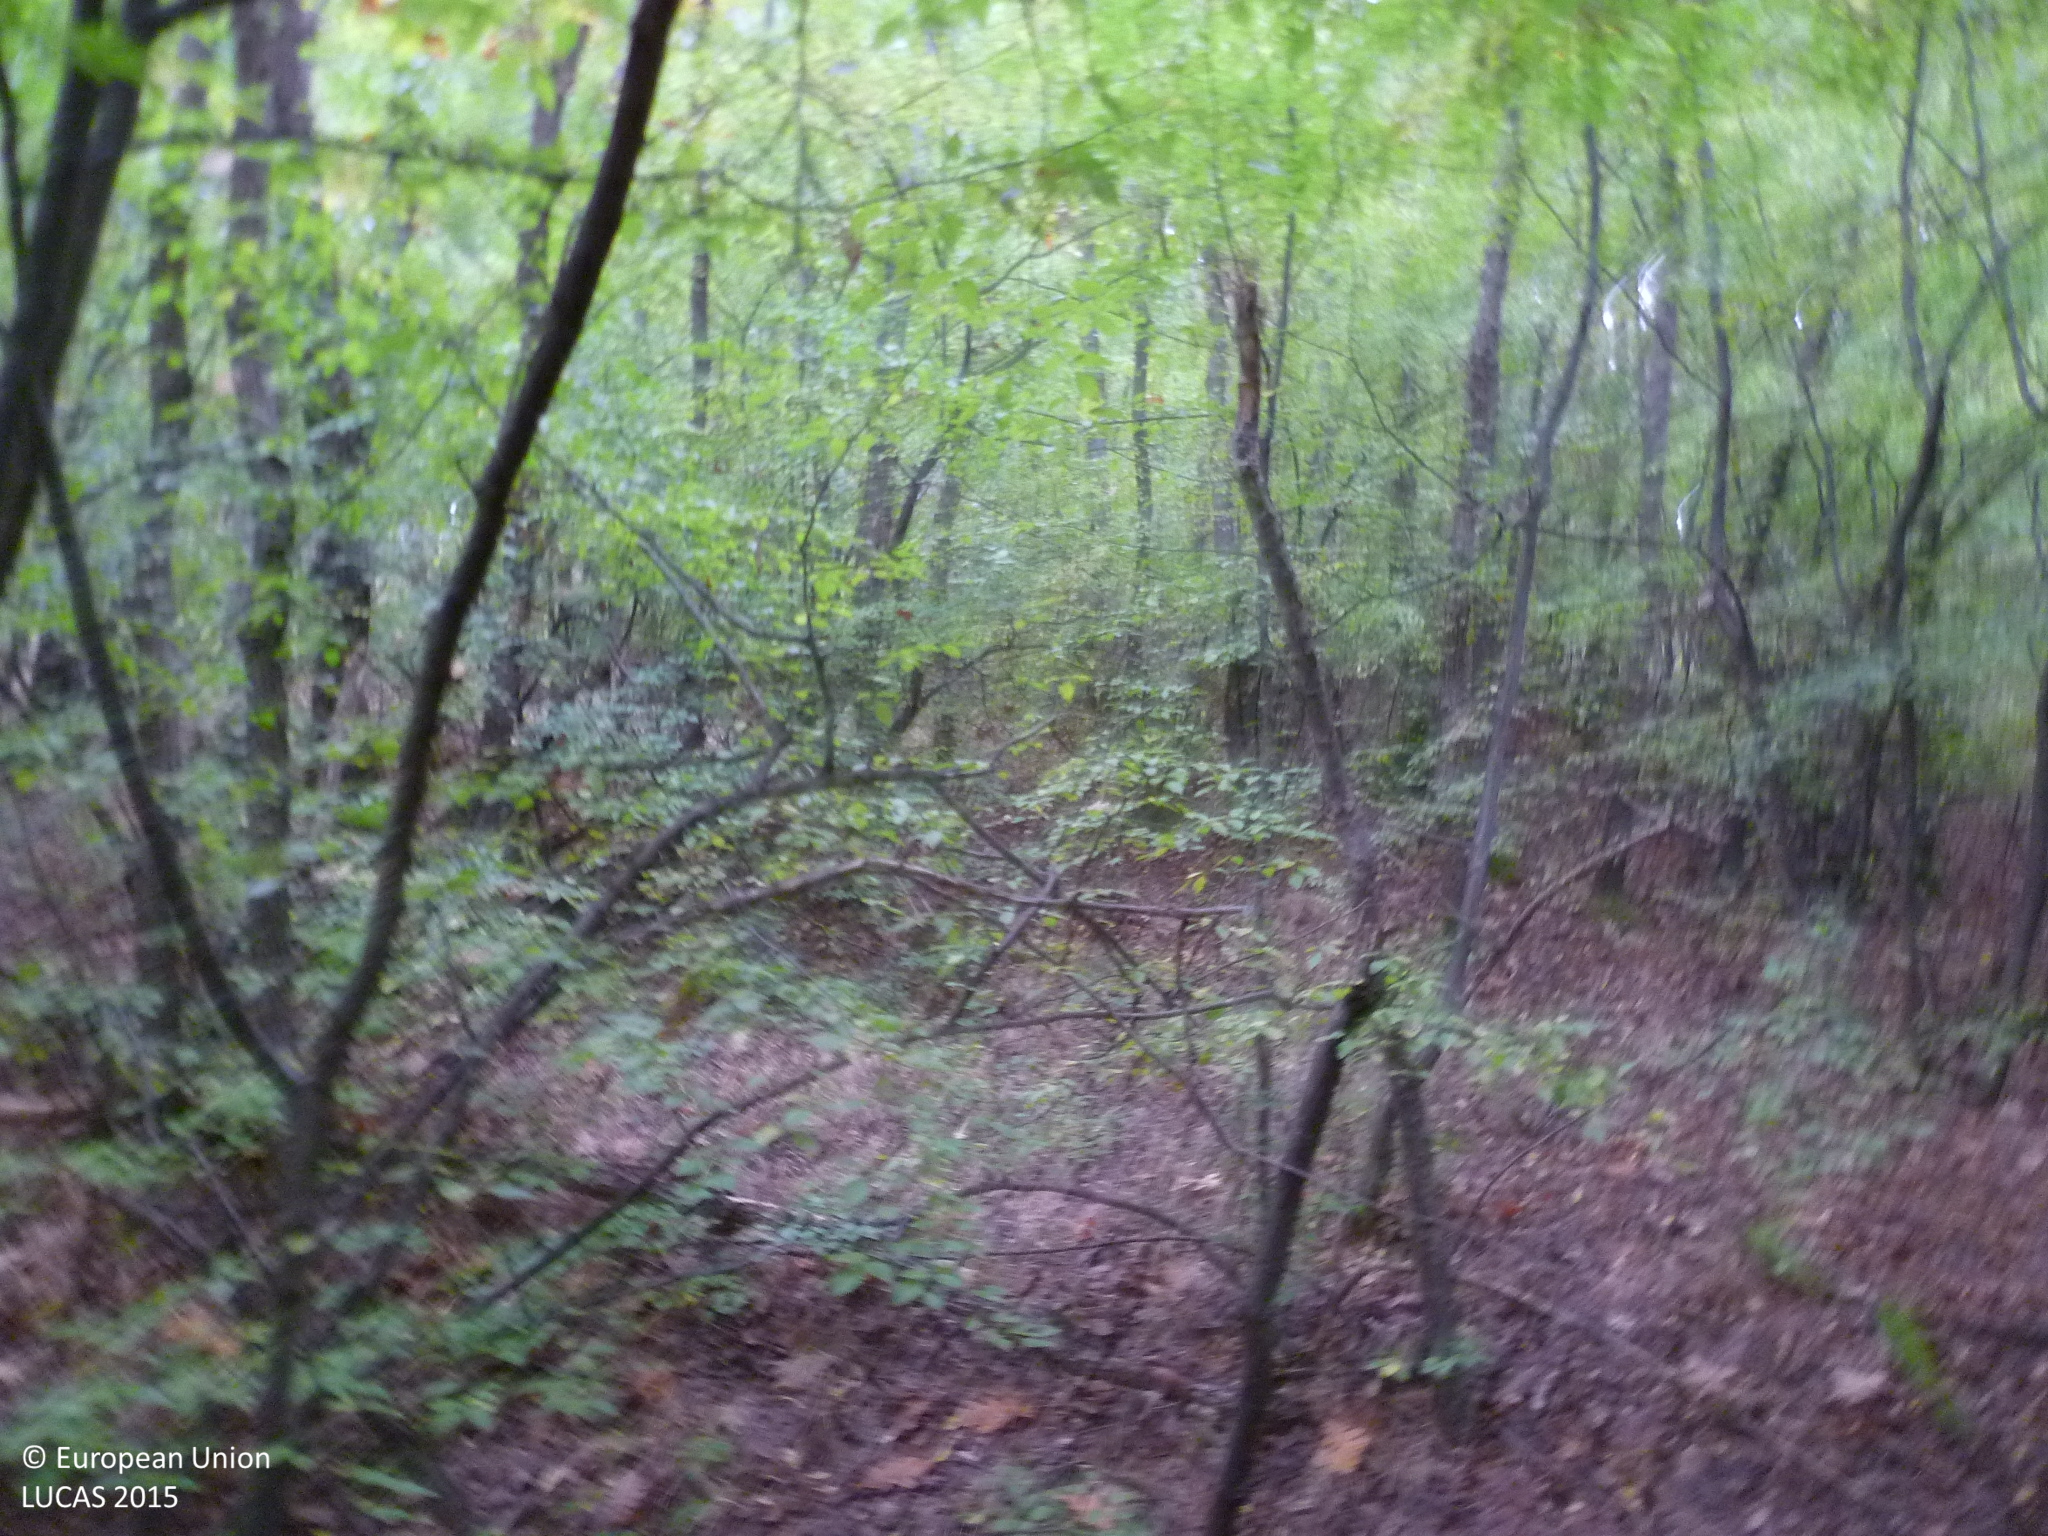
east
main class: Woodland
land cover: Broadleaved woodland
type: mesophytic deciduous forest
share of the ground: > 75 %
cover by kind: broadleaved forest trees 80 %, unconsolidated bare surface 15 %, lichens and mosses 5 %
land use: Forestry
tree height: > 5 m
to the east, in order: Broadleaved woodland; Pine dominated coniferous woodland; Rock outcrops; Broadleaved woodland; Tracks; Broadleaved woodland; Pine dominated coniferous woodland
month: October
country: BG
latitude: 42.3603
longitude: 23.8189
